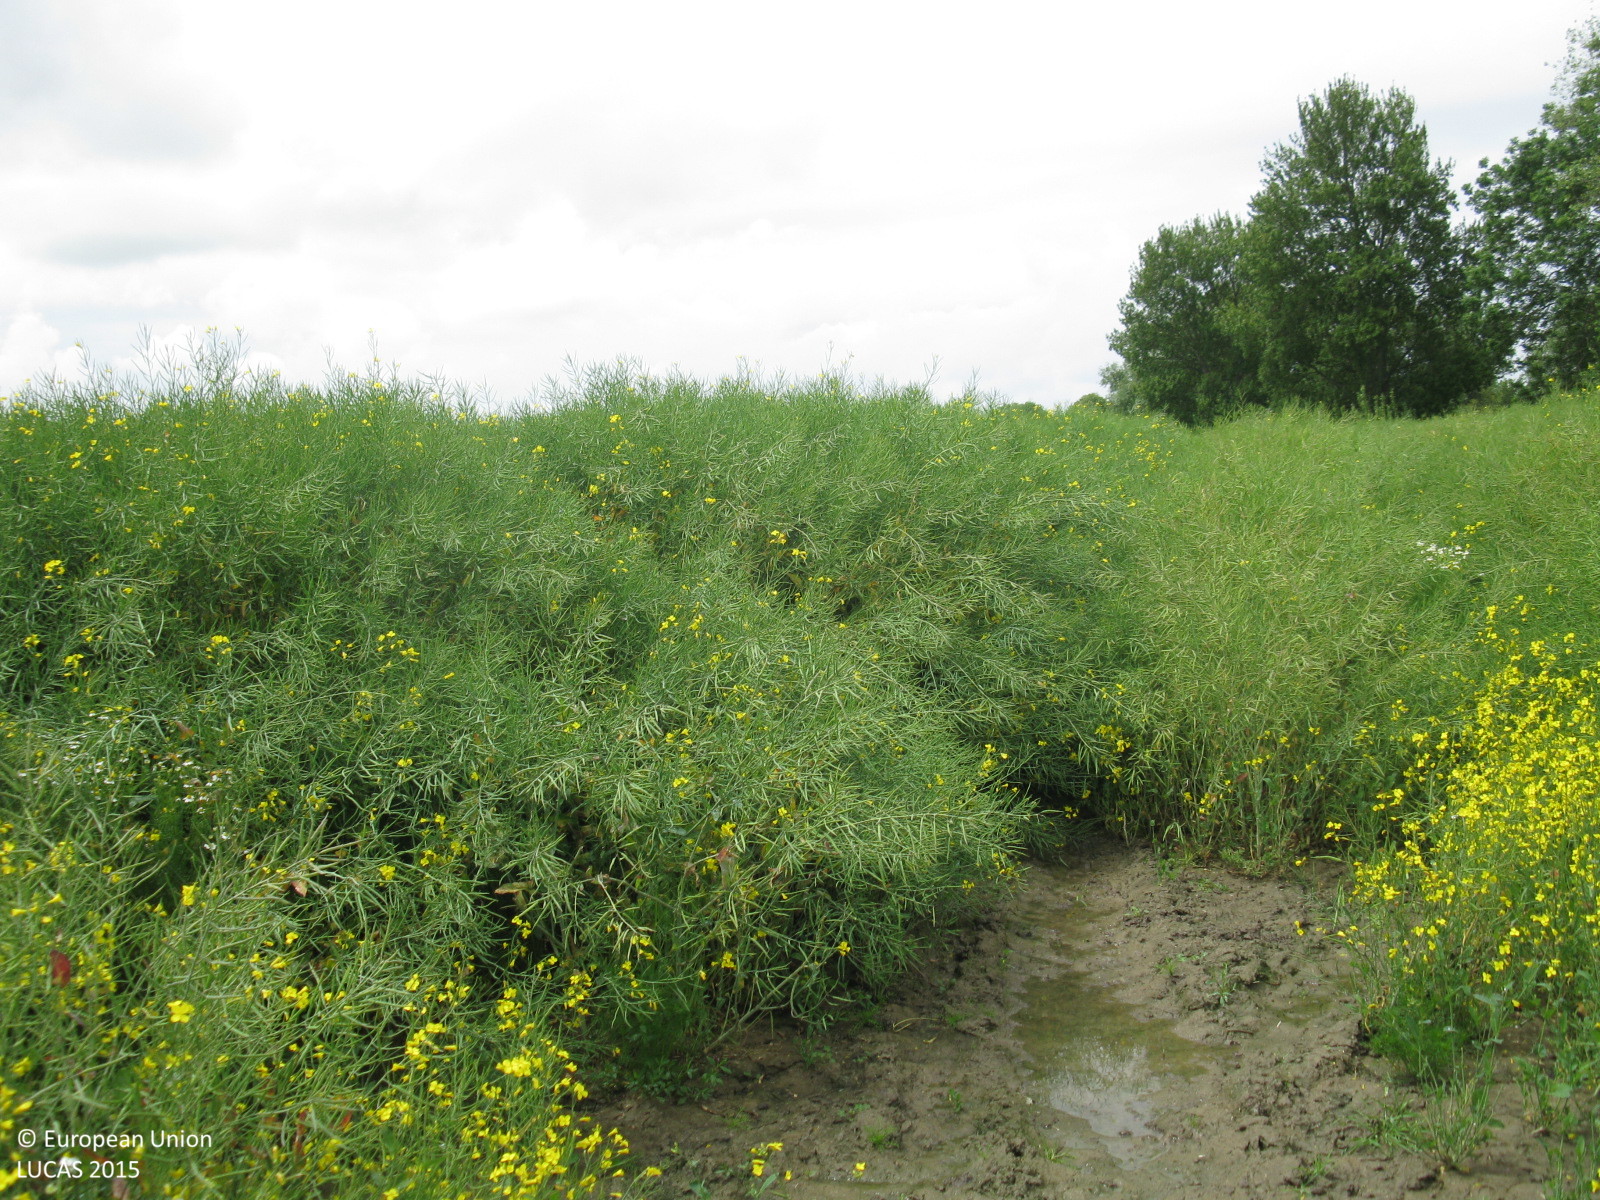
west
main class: Cropland
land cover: Rape and turnip rape
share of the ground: > 75 %
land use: Agriculture (excluding fallow land and kitchen gardens)
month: June
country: DE
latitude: 53.7088
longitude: 7.9858
